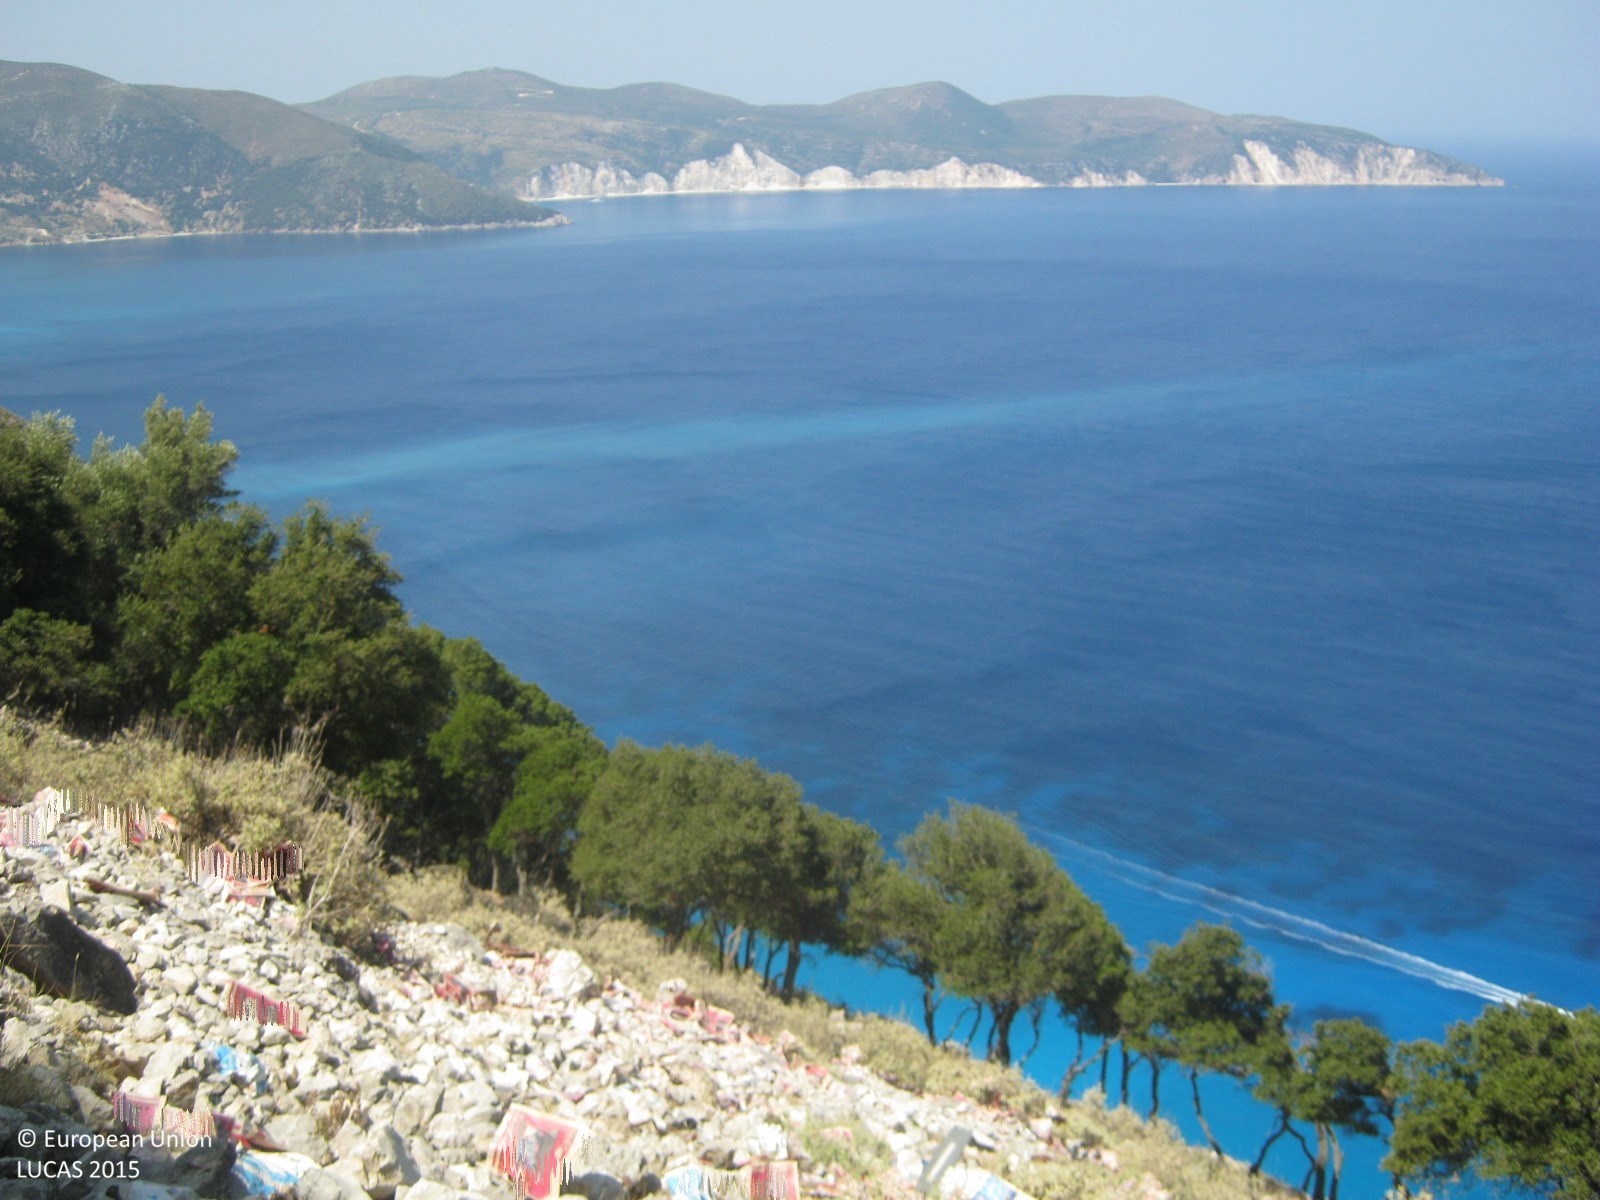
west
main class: Woodland
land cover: Broadleaved woodland
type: broadleaved evergreen forest
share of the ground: 50 - 75 %
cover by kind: broadleaved forest trees 65 %, consolidated bare surface 15 %, coniferous forest trees 10 %, shrubs 5 %, herbaceous plants 5 %
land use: Semi-natural and natural areas not in use
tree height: < 5 m
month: August
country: GR
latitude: 38.3315
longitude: 20.5214
